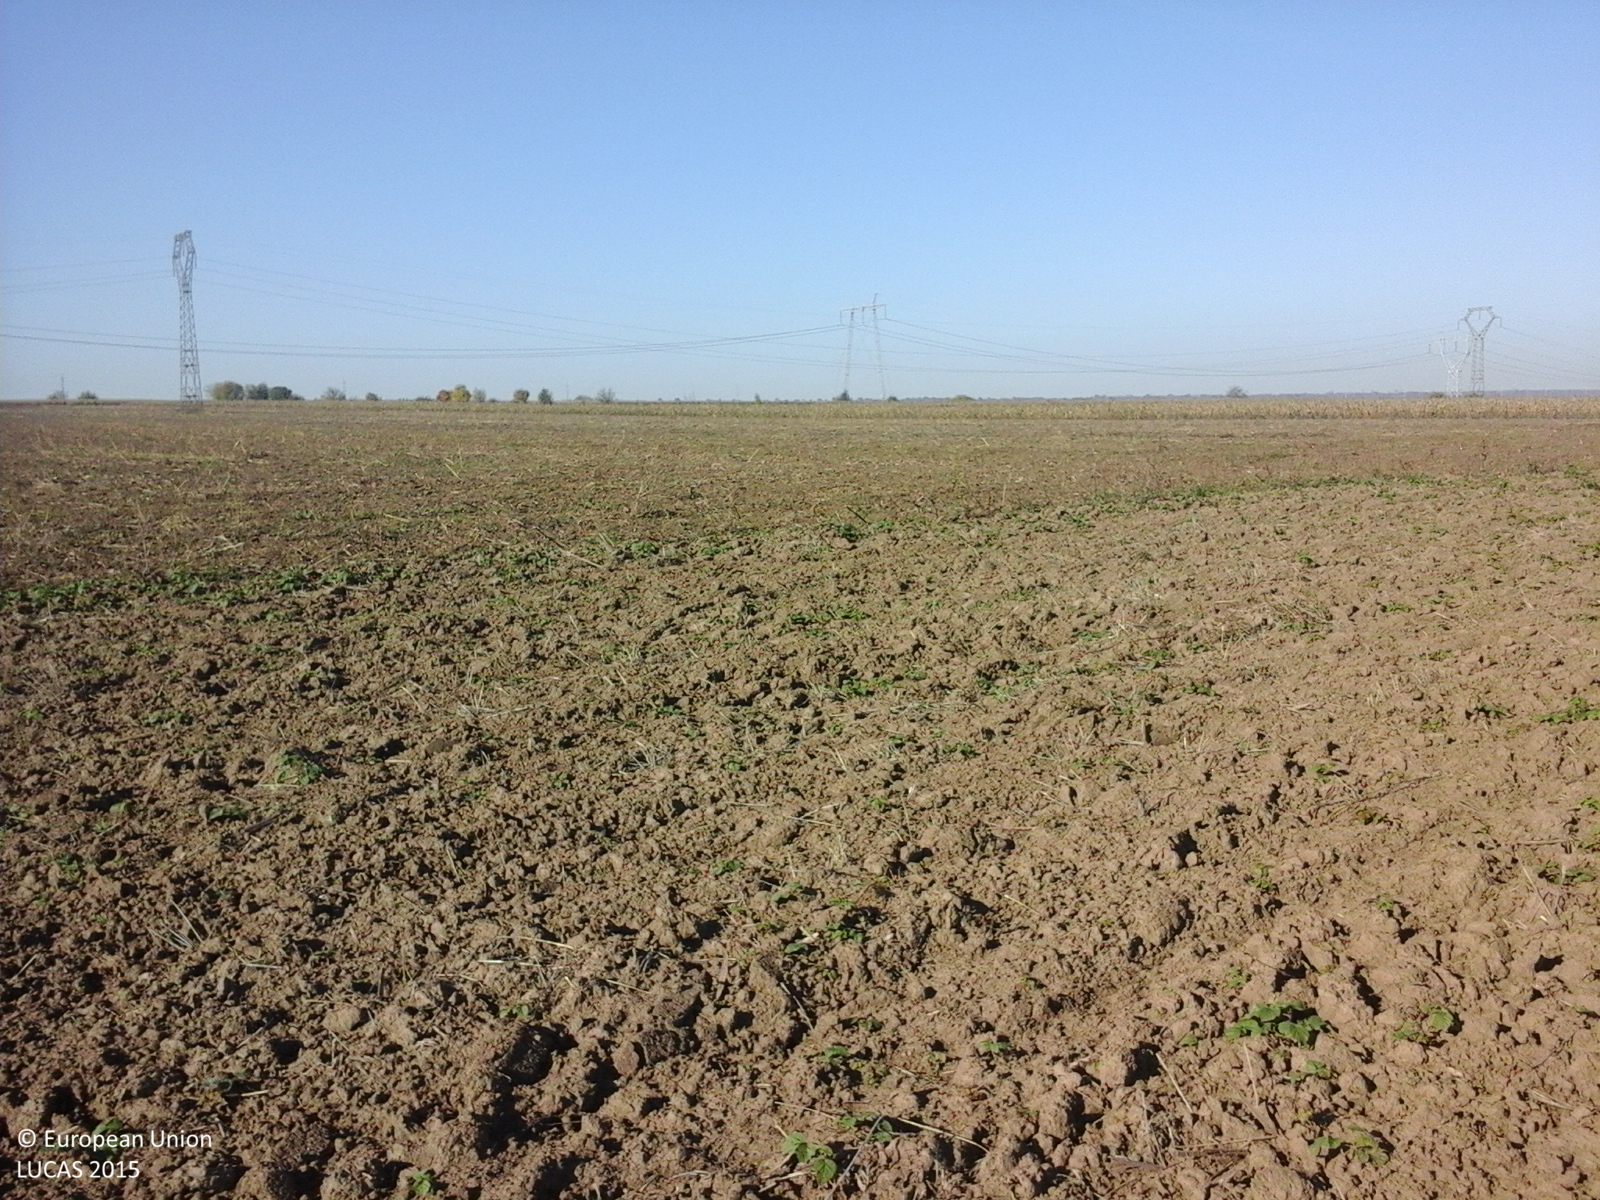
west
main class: Cropland
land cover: Common wheat
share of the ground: < 10 %
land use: Agriculture (excluding fallow land and kitchen gardens)
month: October
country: RO
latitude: 45.9442
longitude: 27.1622
